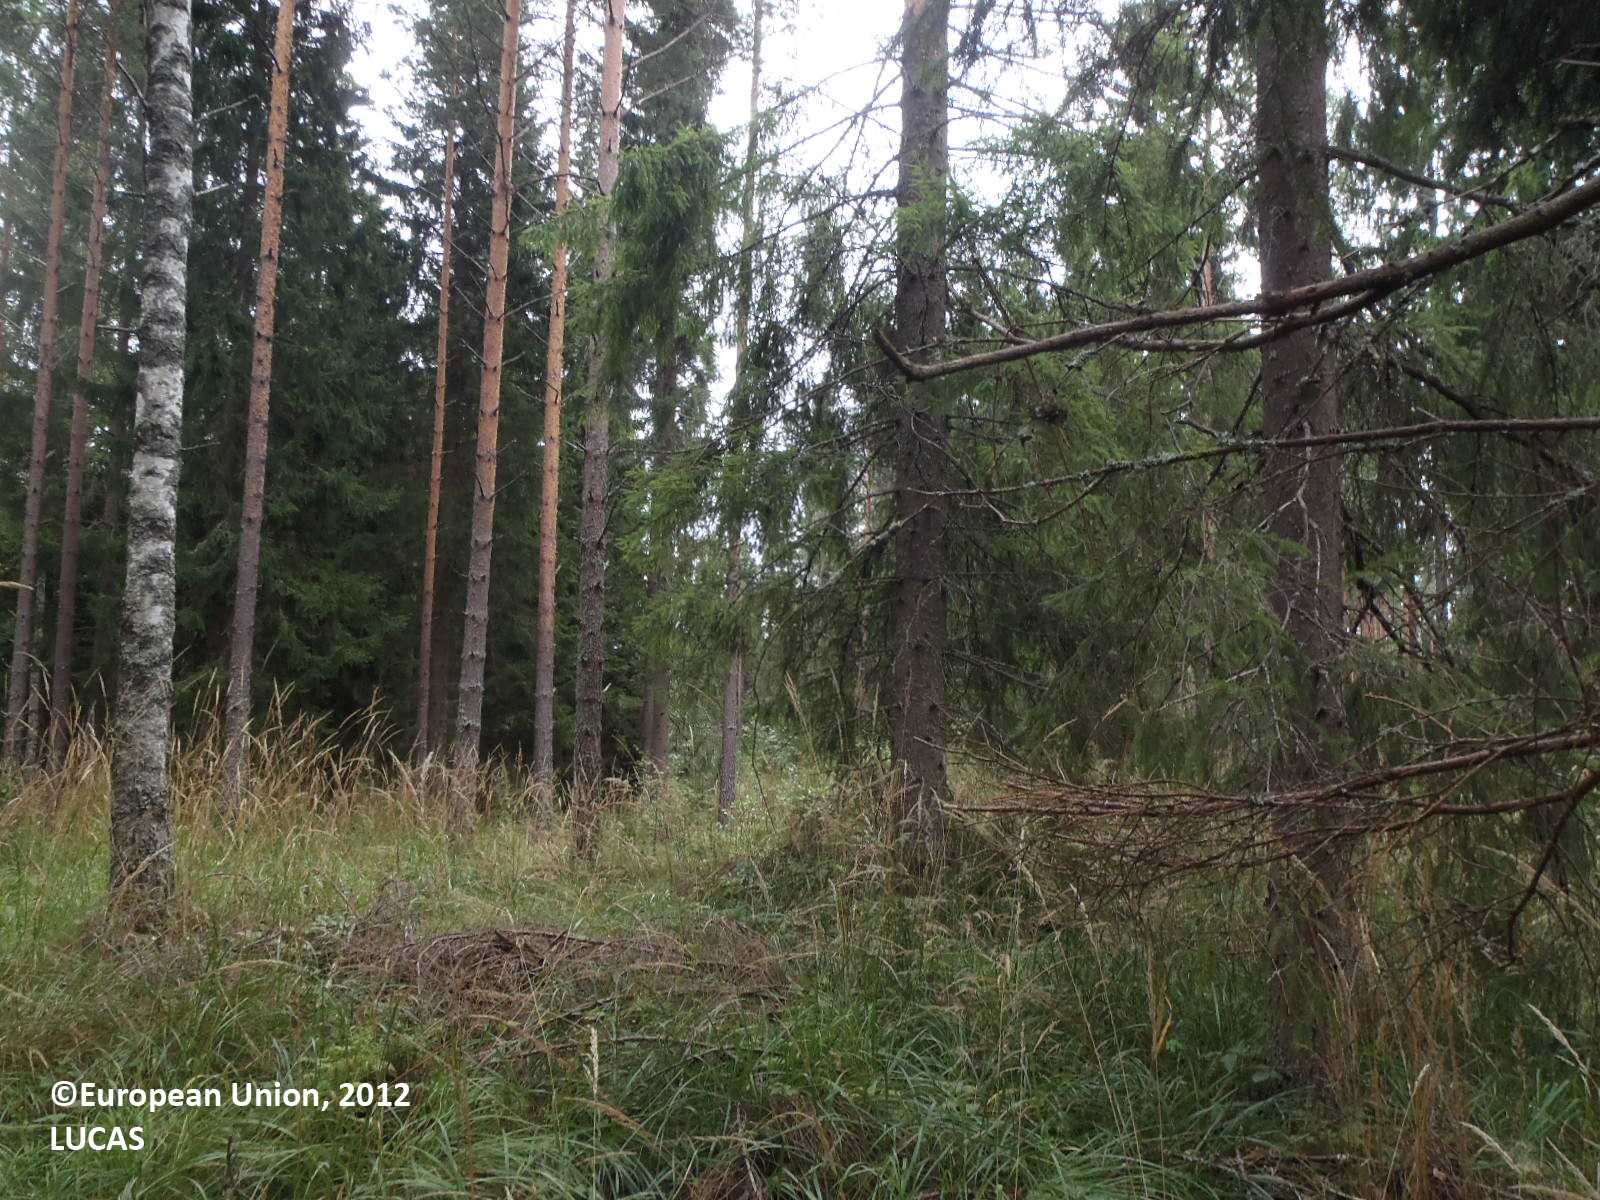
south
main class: Woodland
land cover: Spruce dominated coniferous woodland
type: boreal forest
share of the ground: > 75 %
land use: Forestry
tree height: > 5 m
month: August
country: FI
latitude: 60.7146
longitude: 22.3269
